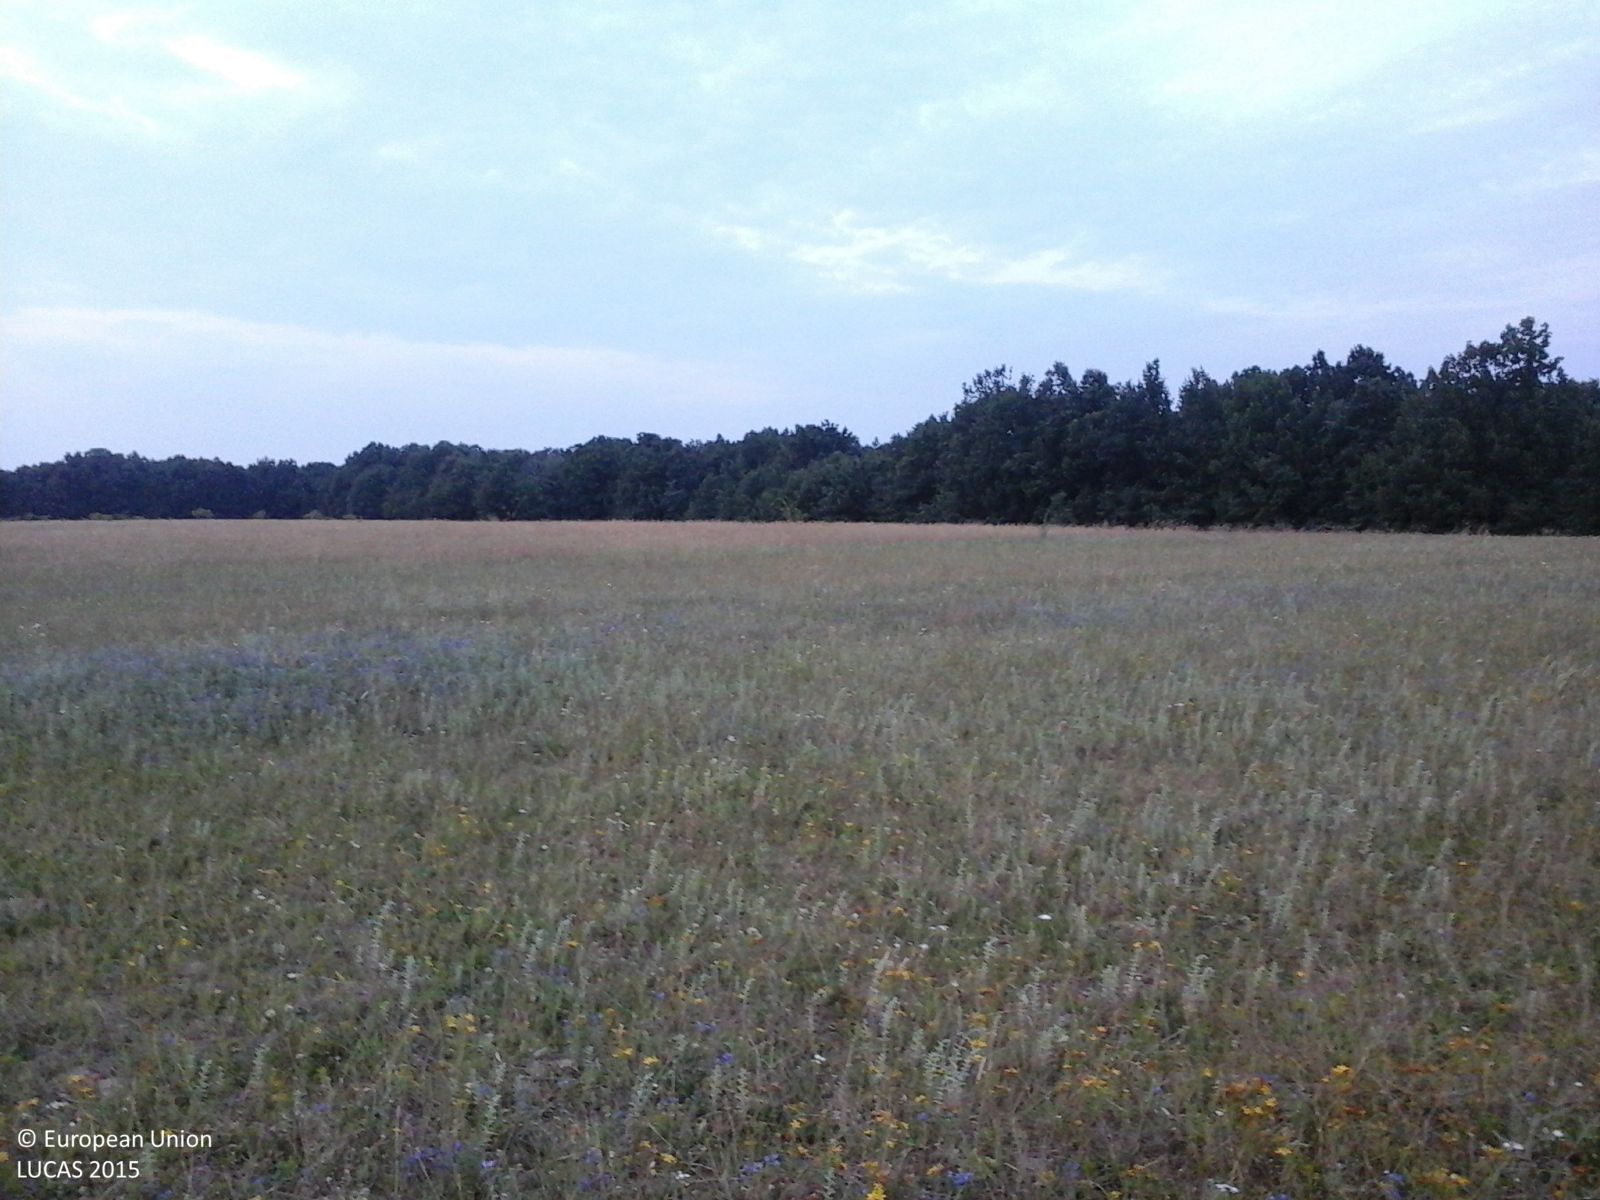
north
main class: Grassland
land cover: Grassland without tree/shrub cover
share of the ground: > 75 %
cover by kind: herbaceous plants 100 %
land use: Agriculture (excluding fallow land and kitchen gardens)
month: July
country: RO
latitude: 44.9103
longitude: 24.5531
